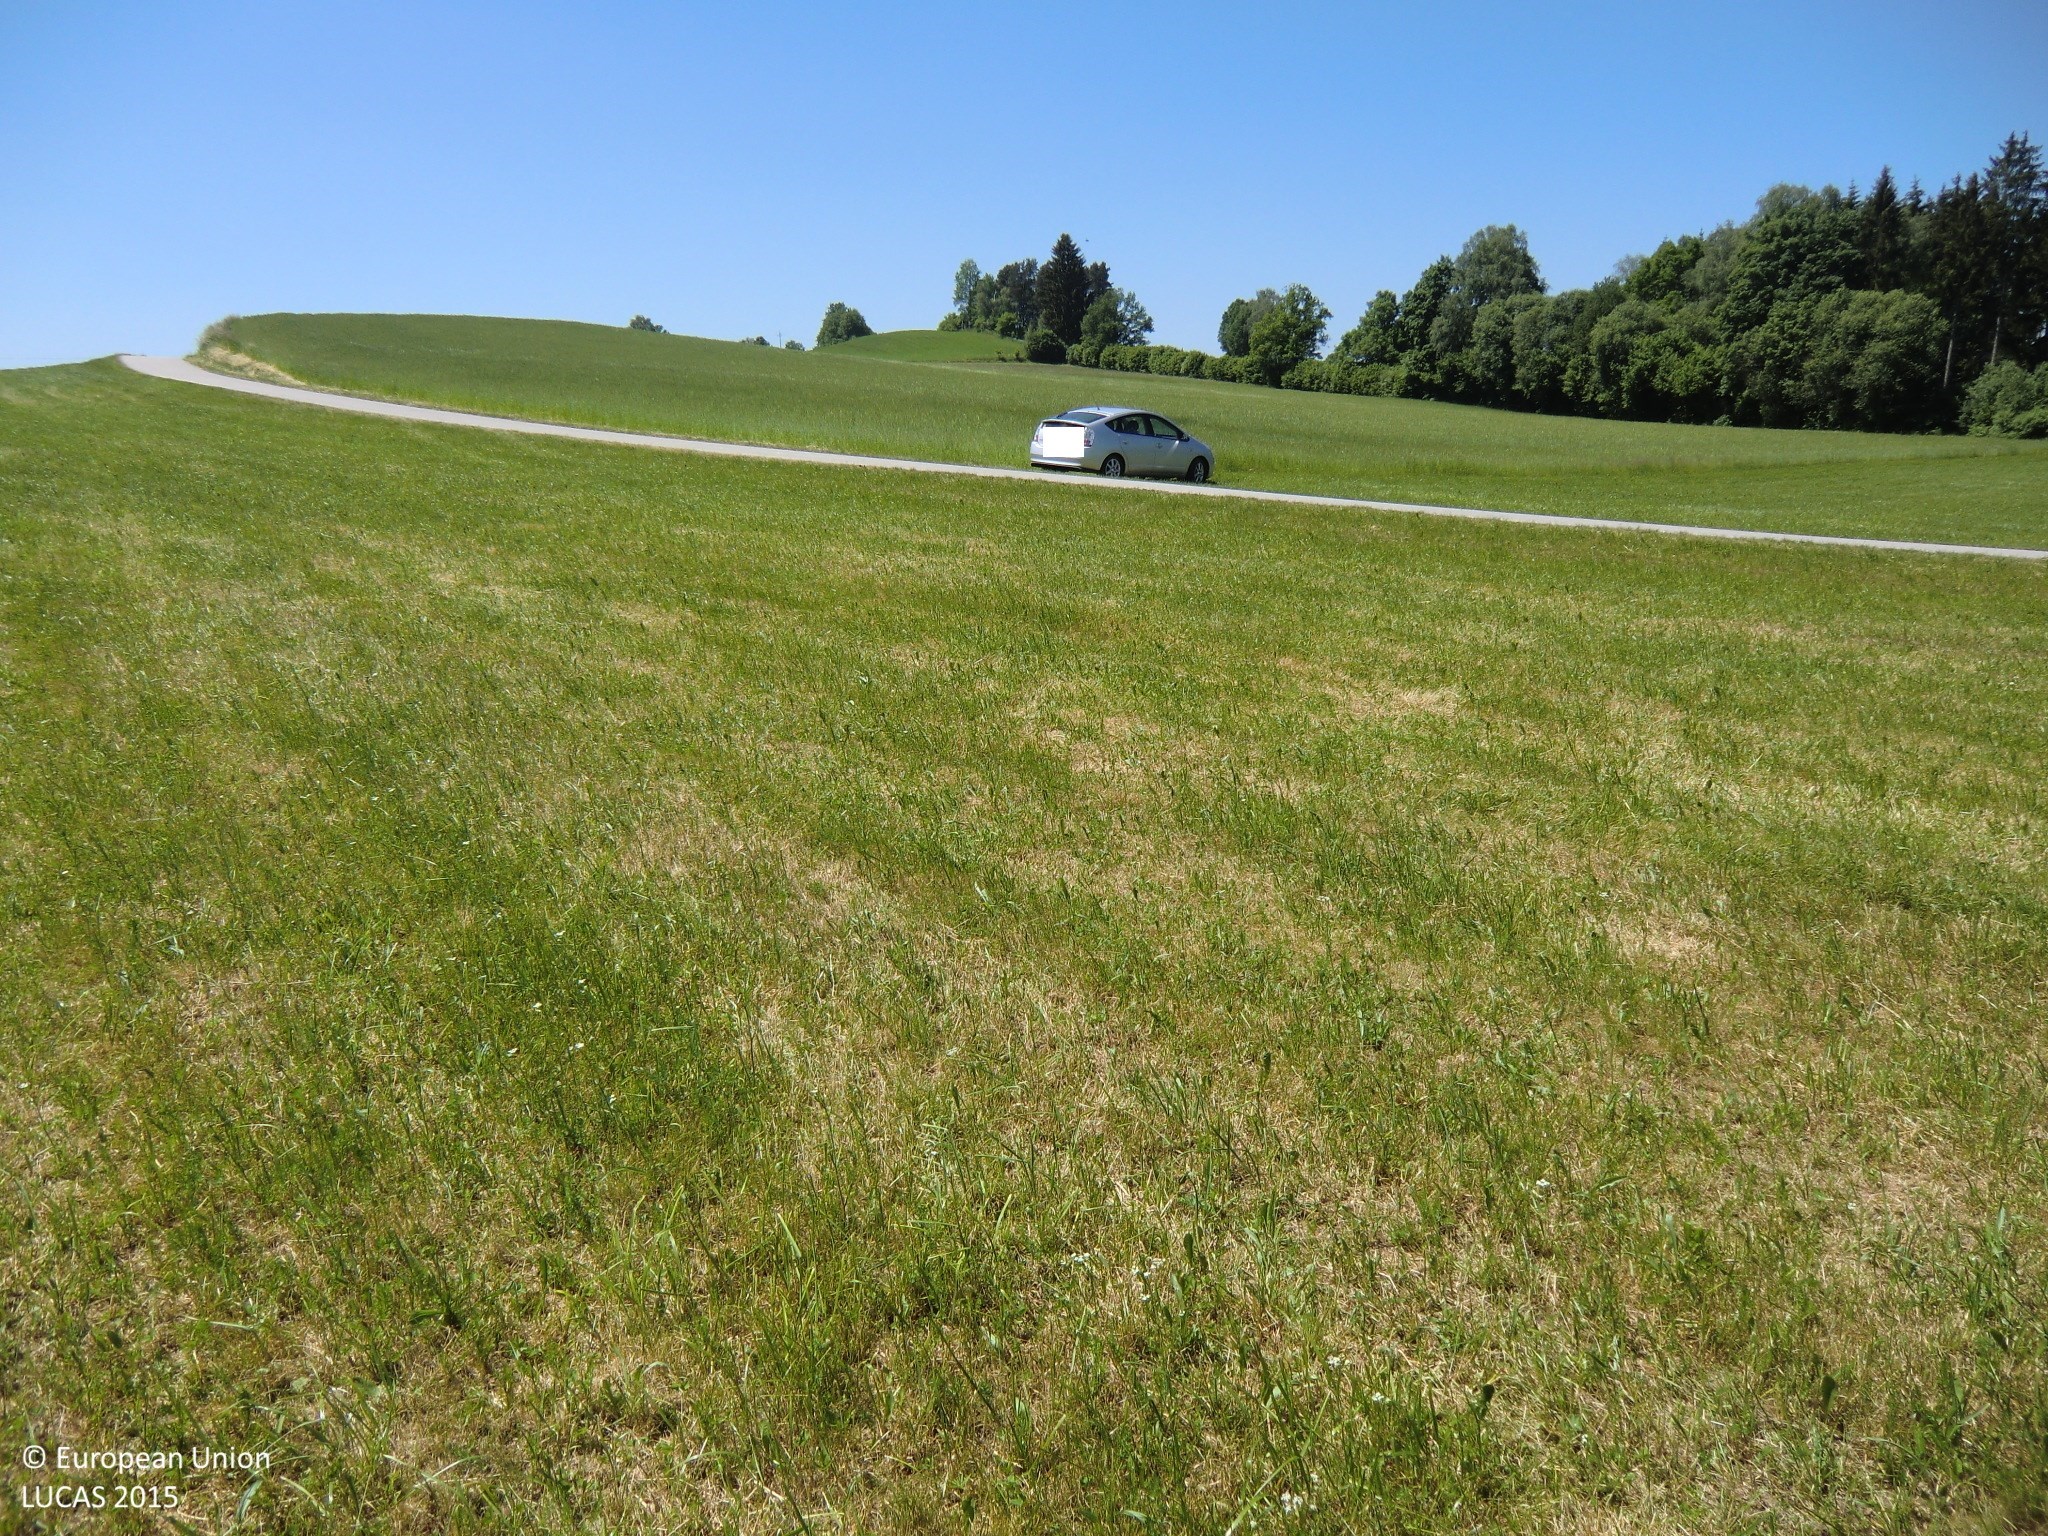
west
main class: Grassland
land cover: Grassland without tree/shrub cover
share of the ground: > 75 %
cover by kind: herbaceous plants 100 %
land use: Agriculture (excluding fallow land and kitchen gardens)
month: June
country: AT
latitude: 48.6377
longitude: 14.4655
